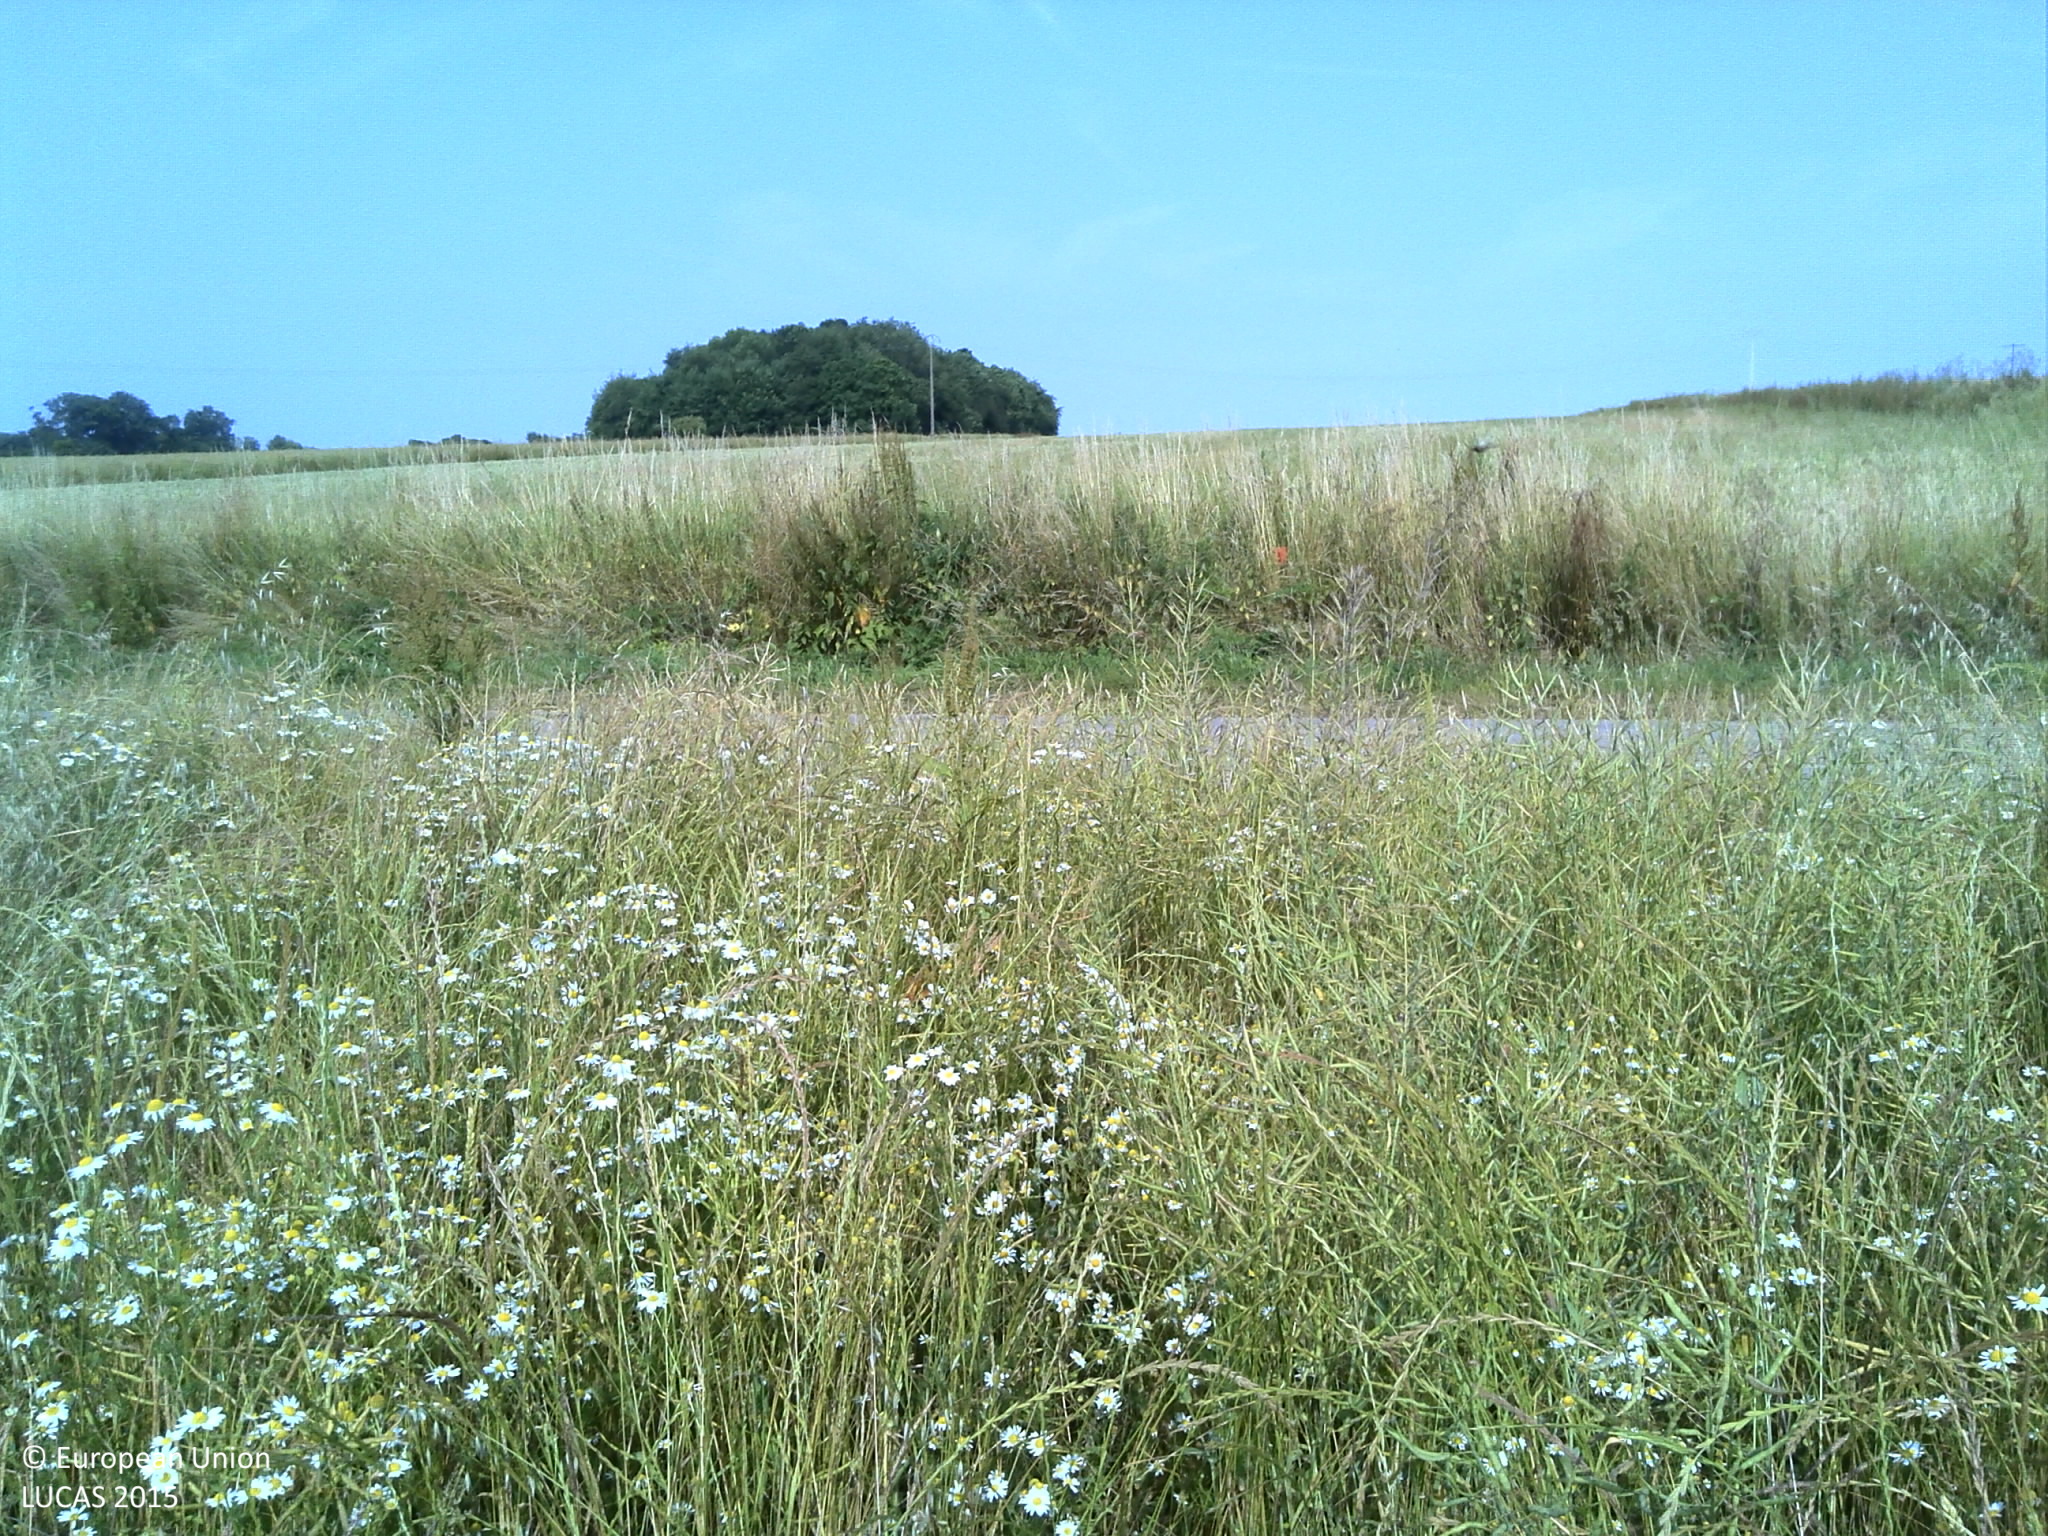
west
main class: Cropland
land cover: Rape and turnip rape
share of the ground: > 75 %
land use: Agriculture (excluding fallow land and kitchen gardens)
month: July
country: FR
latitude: 49.4828
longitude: 1.2144
